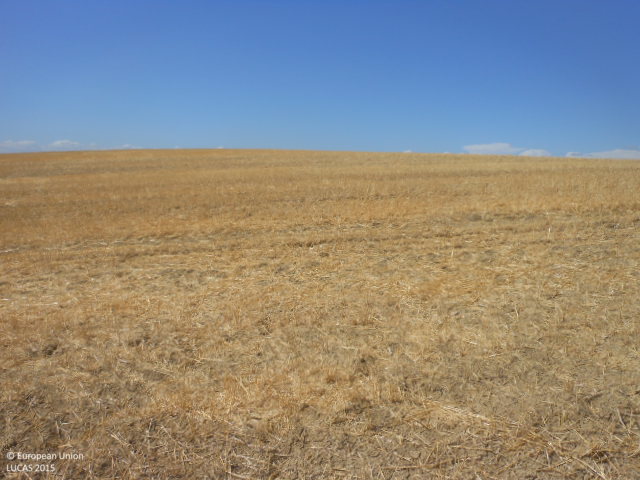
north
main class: Cropland
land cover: Common wheat
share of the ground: < 10 %
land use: Agriculture (excluding fallow land and kitchen gardens)
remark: Harvested field
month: July
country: ES
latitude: 37.4288
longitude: -5.3726
